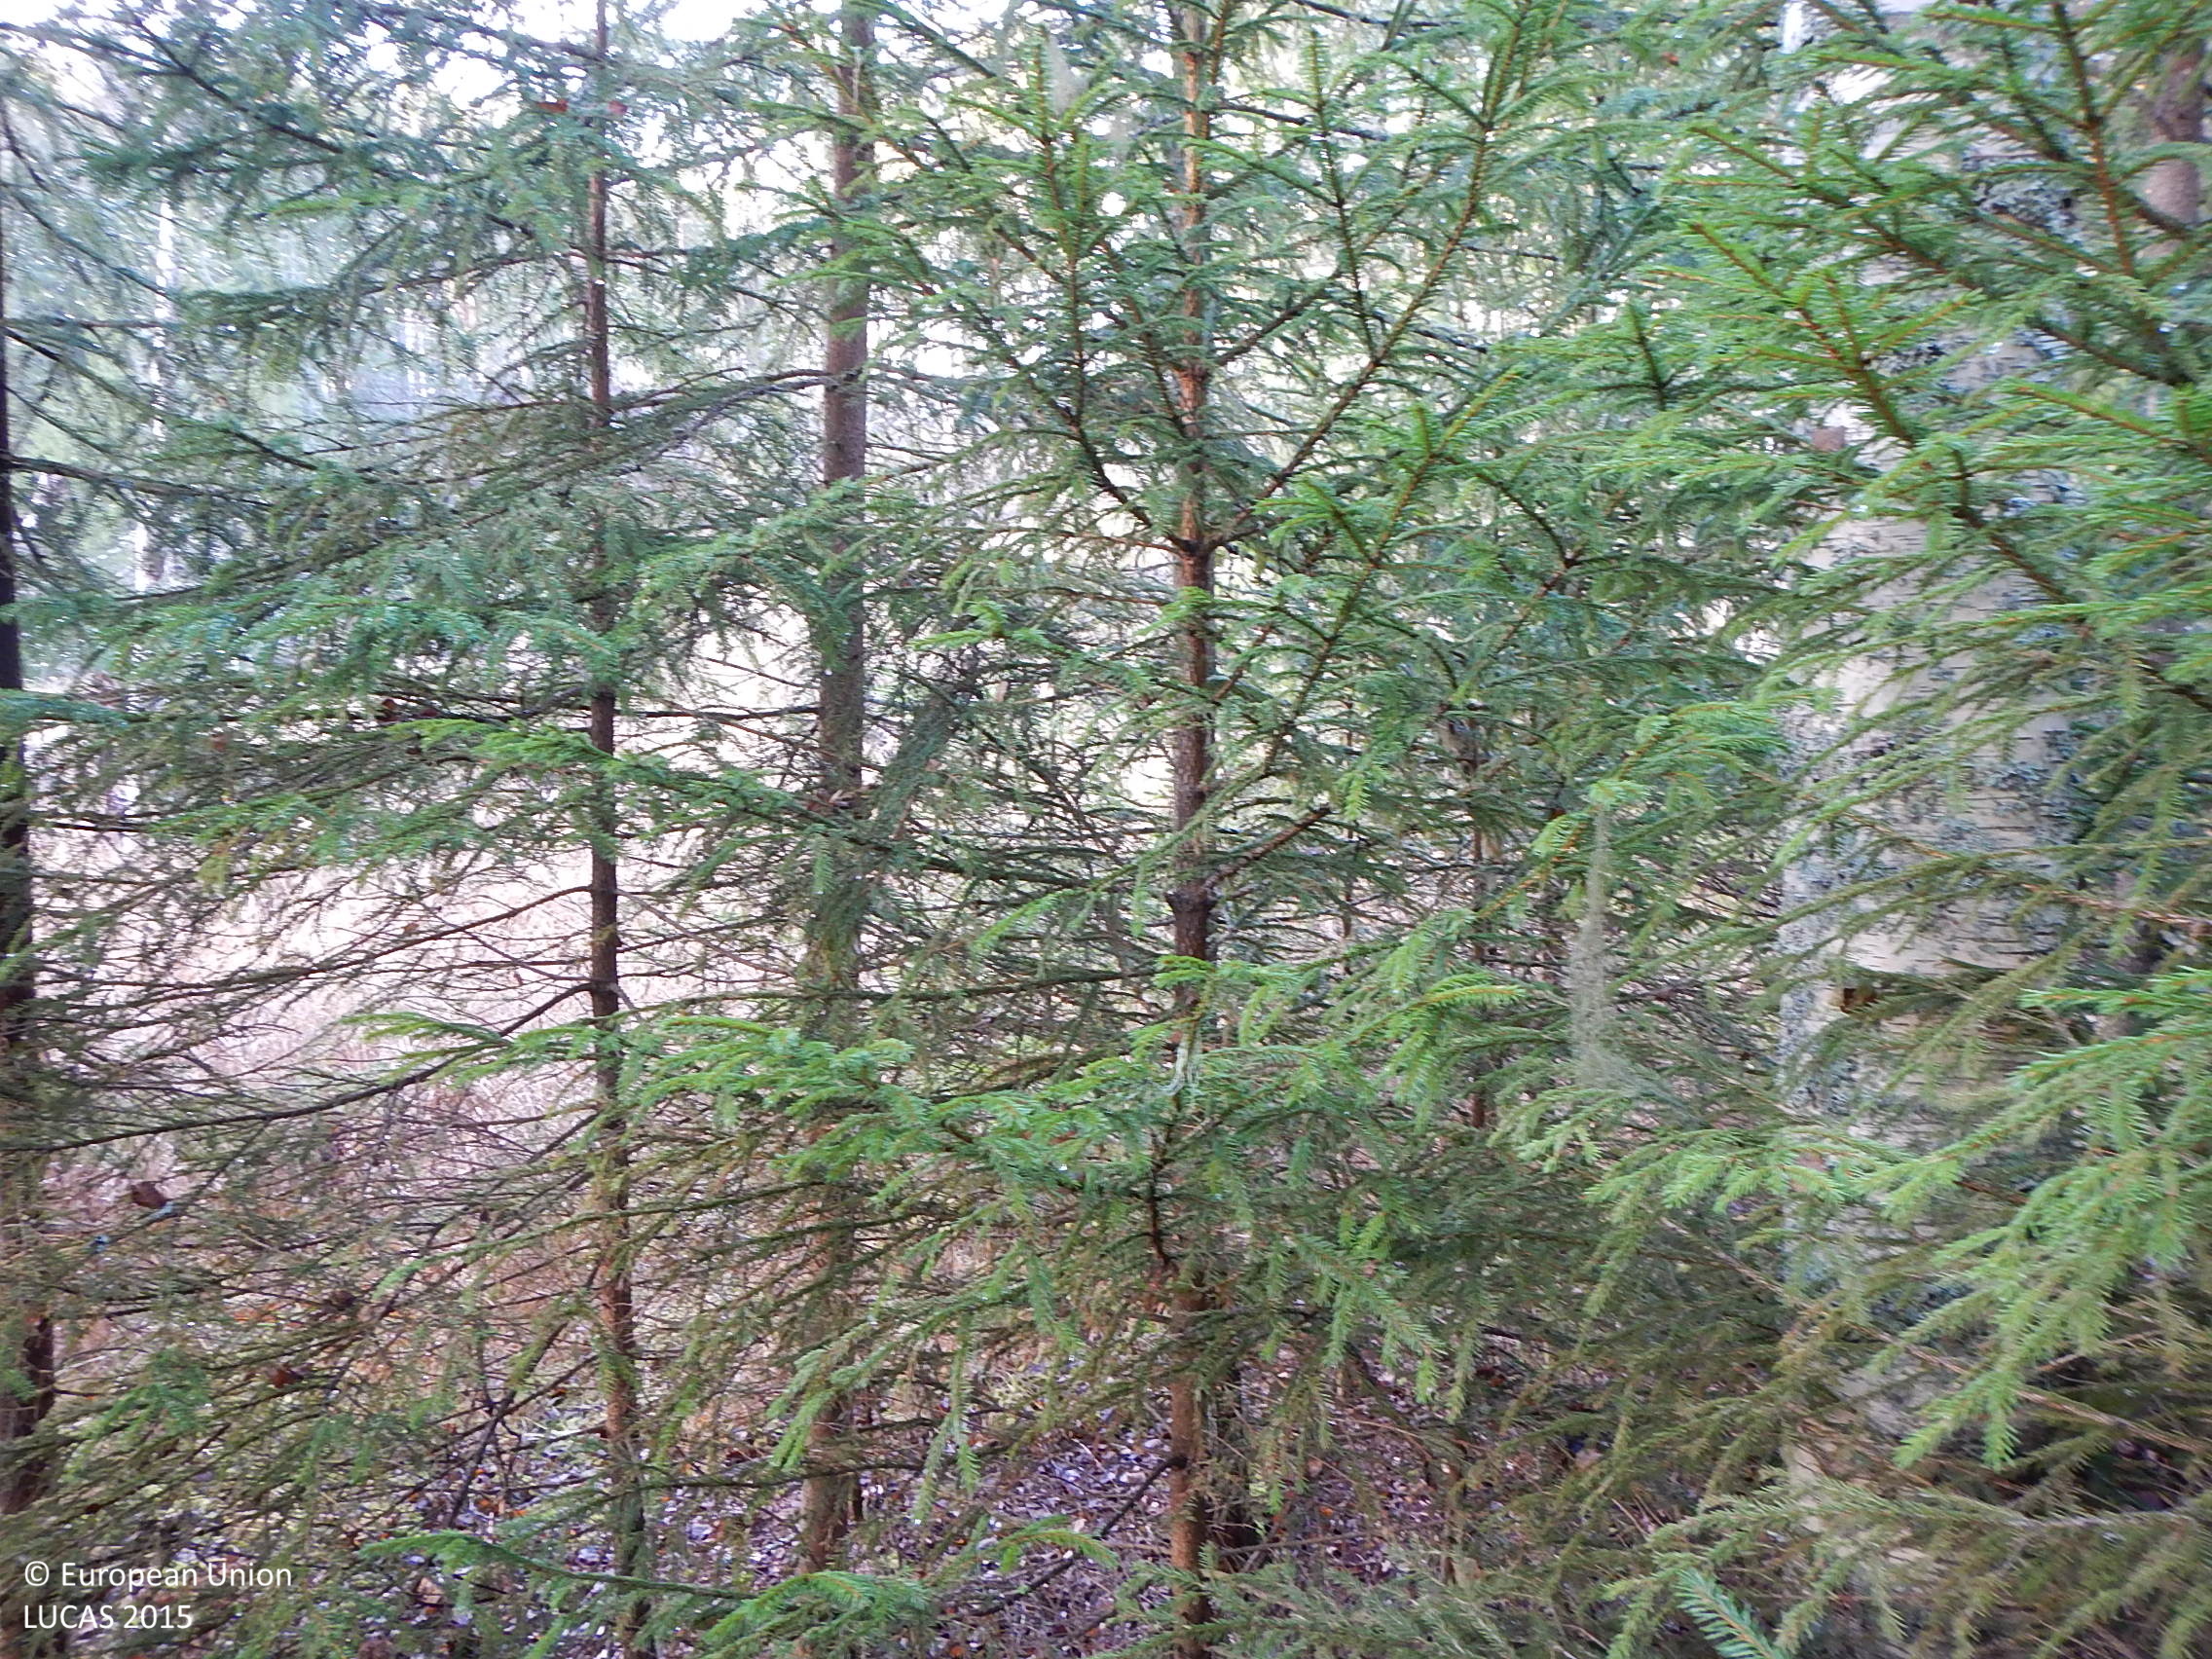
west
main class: Woodland
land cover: Spruce dominated mixed woodland
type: boreal forest
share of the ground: 50 - 75 %
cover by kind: coniferous forest trees 45 %, broadleaved forest trees 25 %, herbaceous plants 15 %, lichens and mosses 10 %, shrubs 5 %
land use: Forestry
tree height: > 5 m
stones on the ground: < 10 %
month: November
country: SE
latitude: 61.7536
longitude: 16.7830
